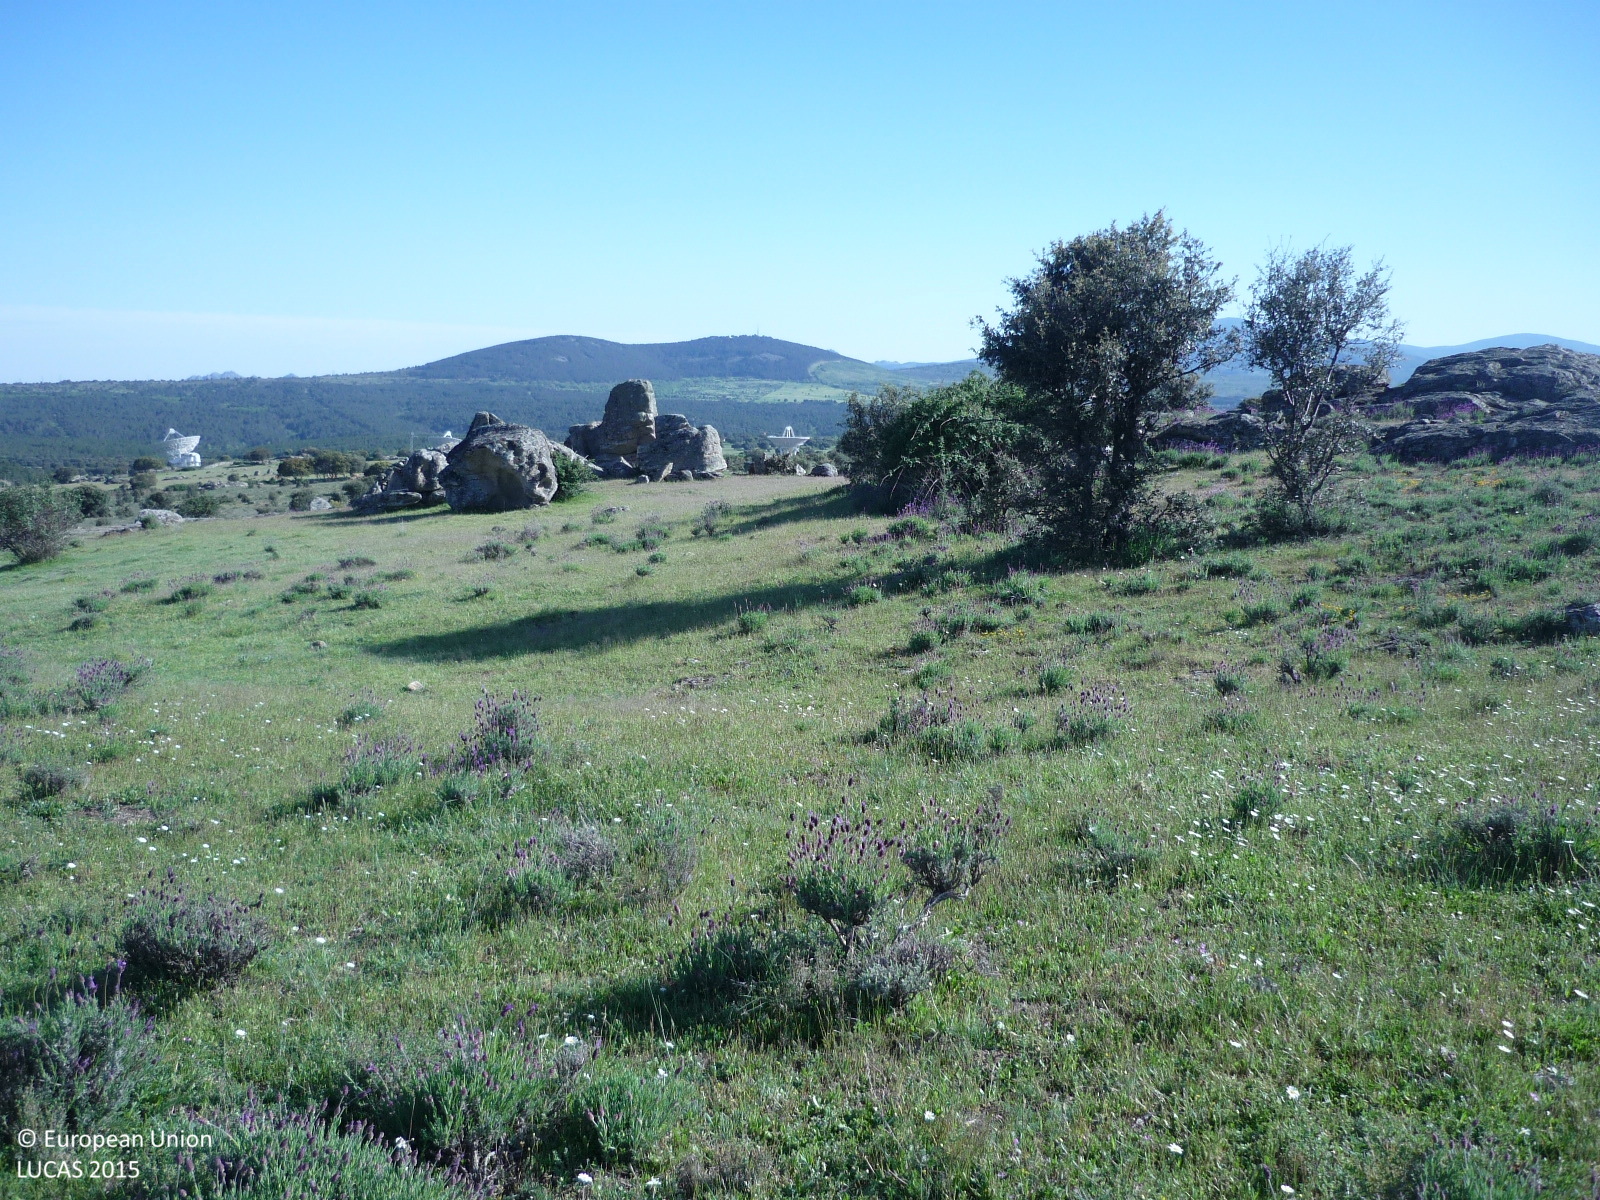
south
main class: Grassland
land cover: Grassland with sparse tree/shrub cover
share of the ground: > 75 %
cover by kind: herbaceous plants 80 %, unconsolidated bare surface 10 %, broadleaved forest trees 5 %, shrubs 5 %
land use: Agriculture (excluding fallow land and kitchen gardens)
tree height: < 5 m
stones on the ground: < 10 %
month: May
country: ES
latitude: 41.0167
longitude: -3.6121
